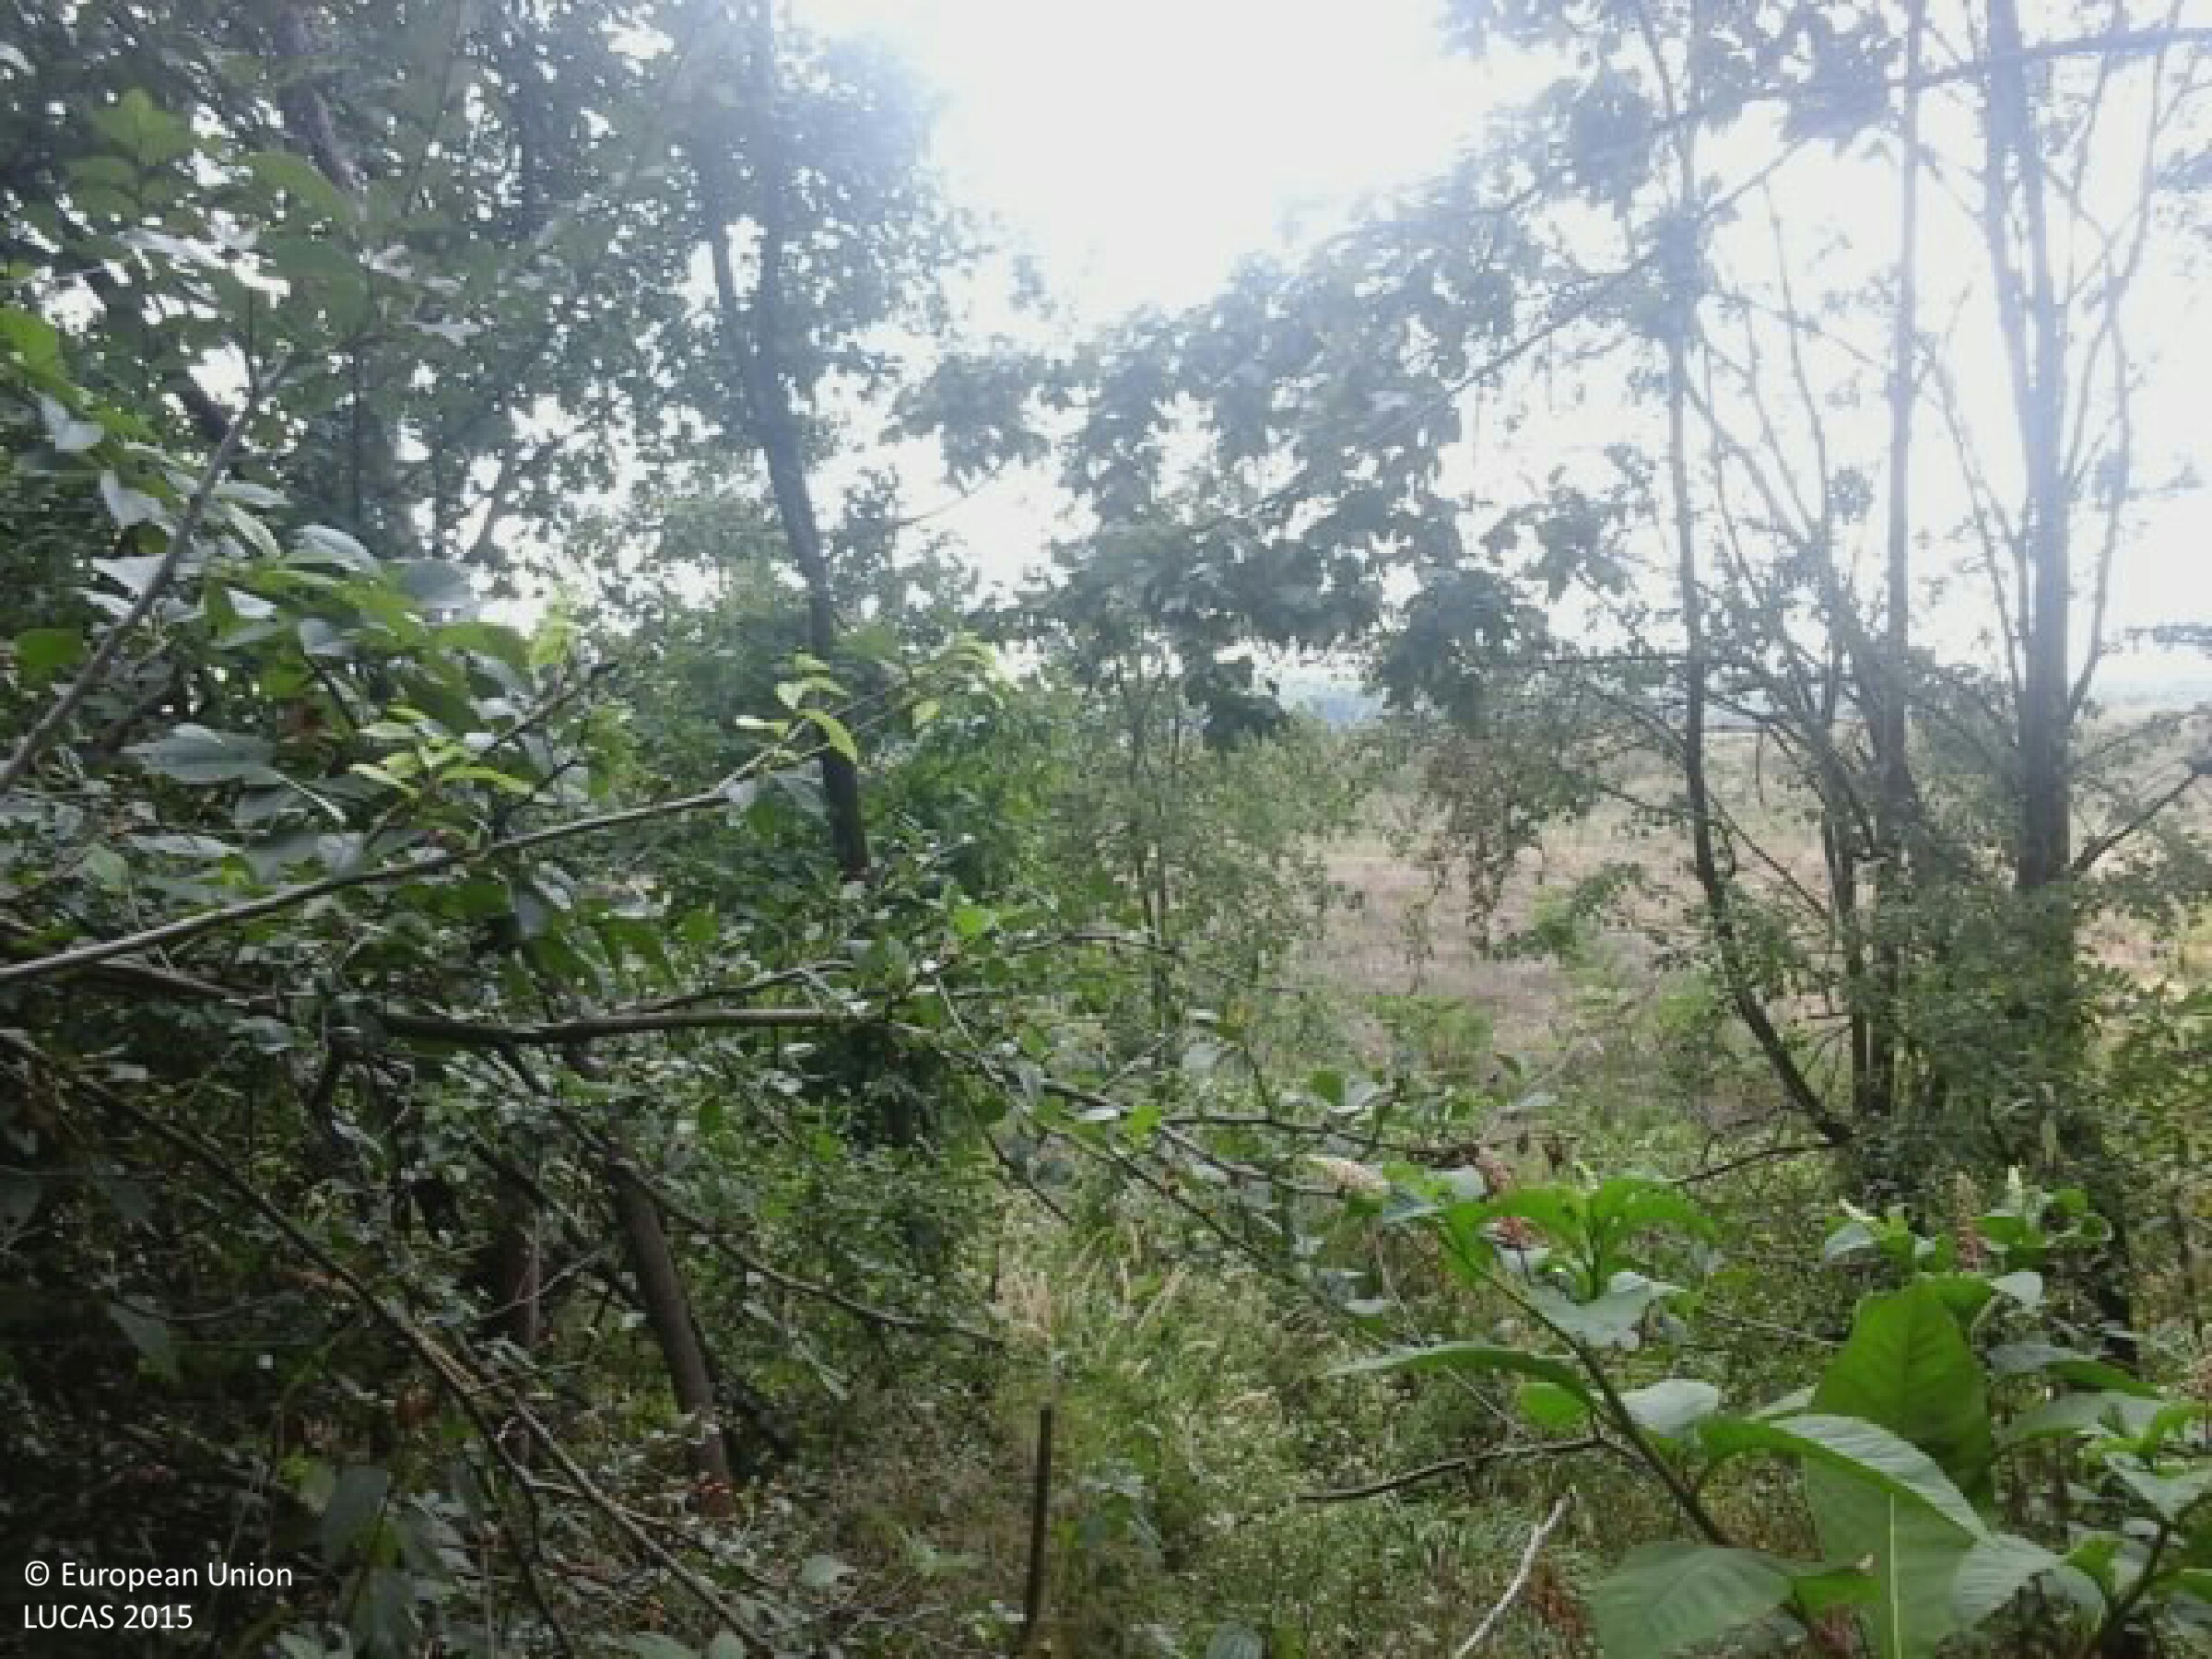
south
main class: Woodland
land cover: Broadleaved woodland
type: mesophytic deciduous forest
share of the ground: > 75 %
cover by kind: broadleaved forest trees 95 %, herbaceous plants 5 %
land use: Forestry
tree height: > 5 m
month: August
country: HU
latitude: 46.1742
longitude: 18.2849
